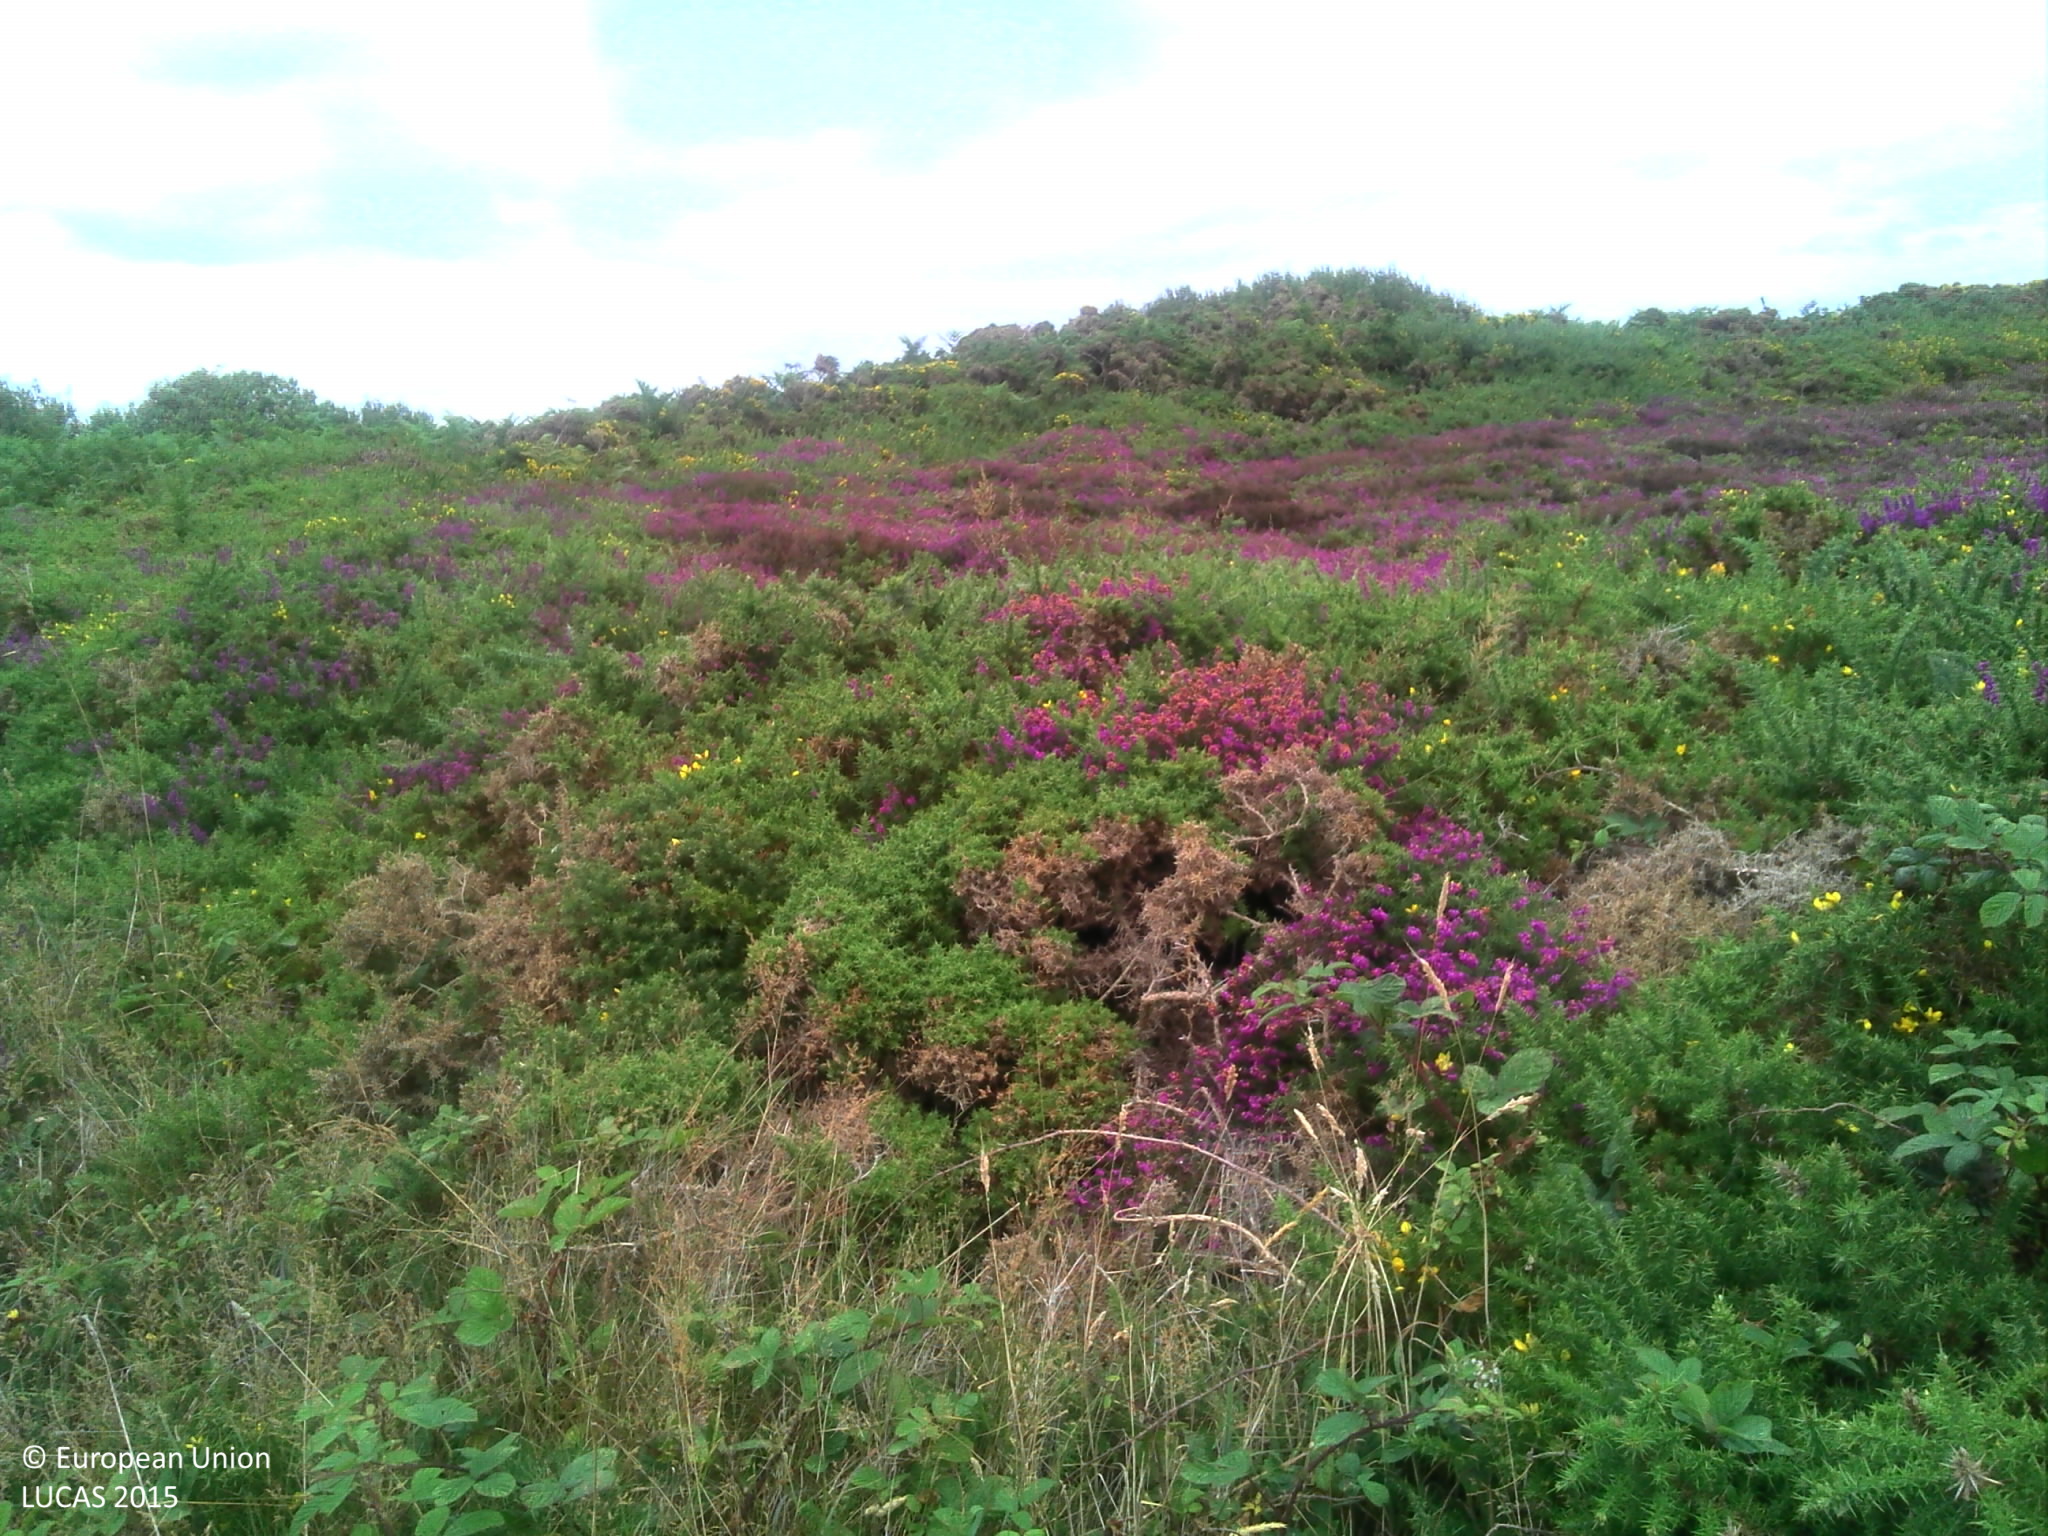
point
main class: Shrubland
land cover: Shrubland without tree cover
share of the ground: > 75 %
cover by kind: shrubs 95 %, herbaceous plants 5 %
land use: Semi-natural and natural areas not in use
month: July
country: FR
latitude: 48.6756
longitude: -2.3229
